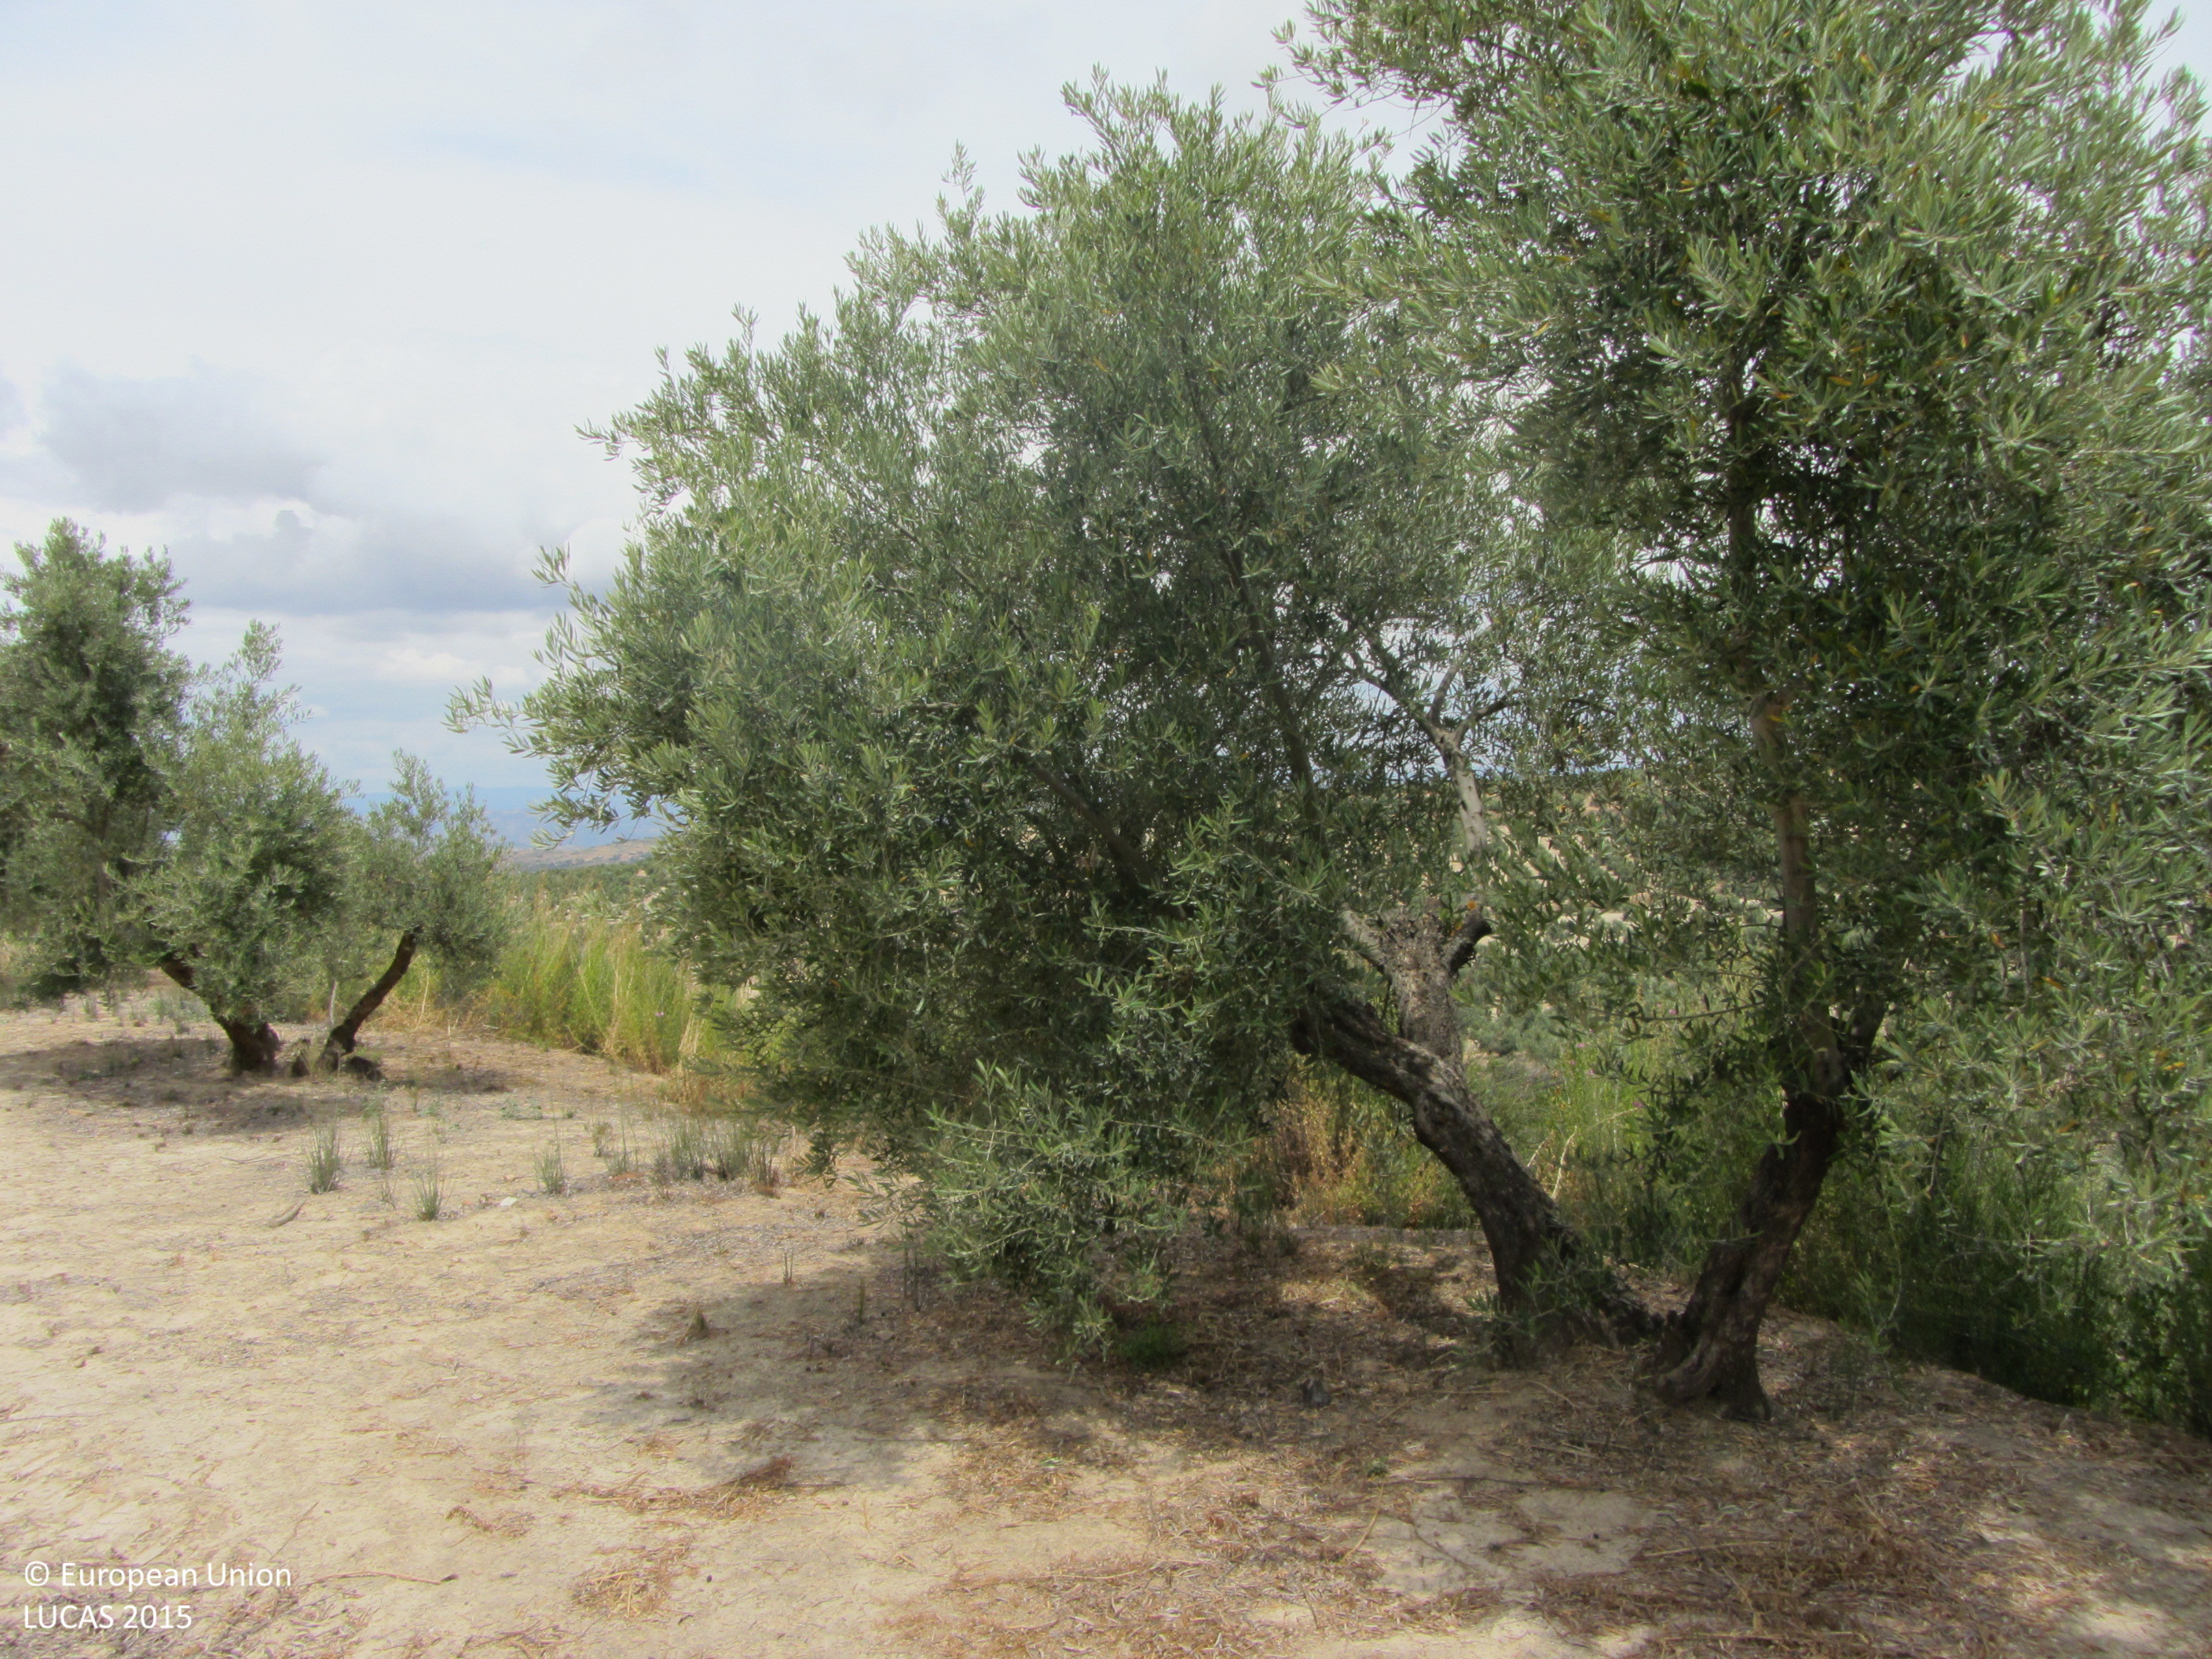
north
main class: Cropland
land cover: Olive groves
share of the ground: 25 - 50 %
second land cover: Other bare soil
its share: > 75 %
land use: Agriculture (excluding fallow land and kitchen gardens)
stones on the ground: < 10 %
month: June
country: ES
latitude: 38.0616
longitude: -3.3930
